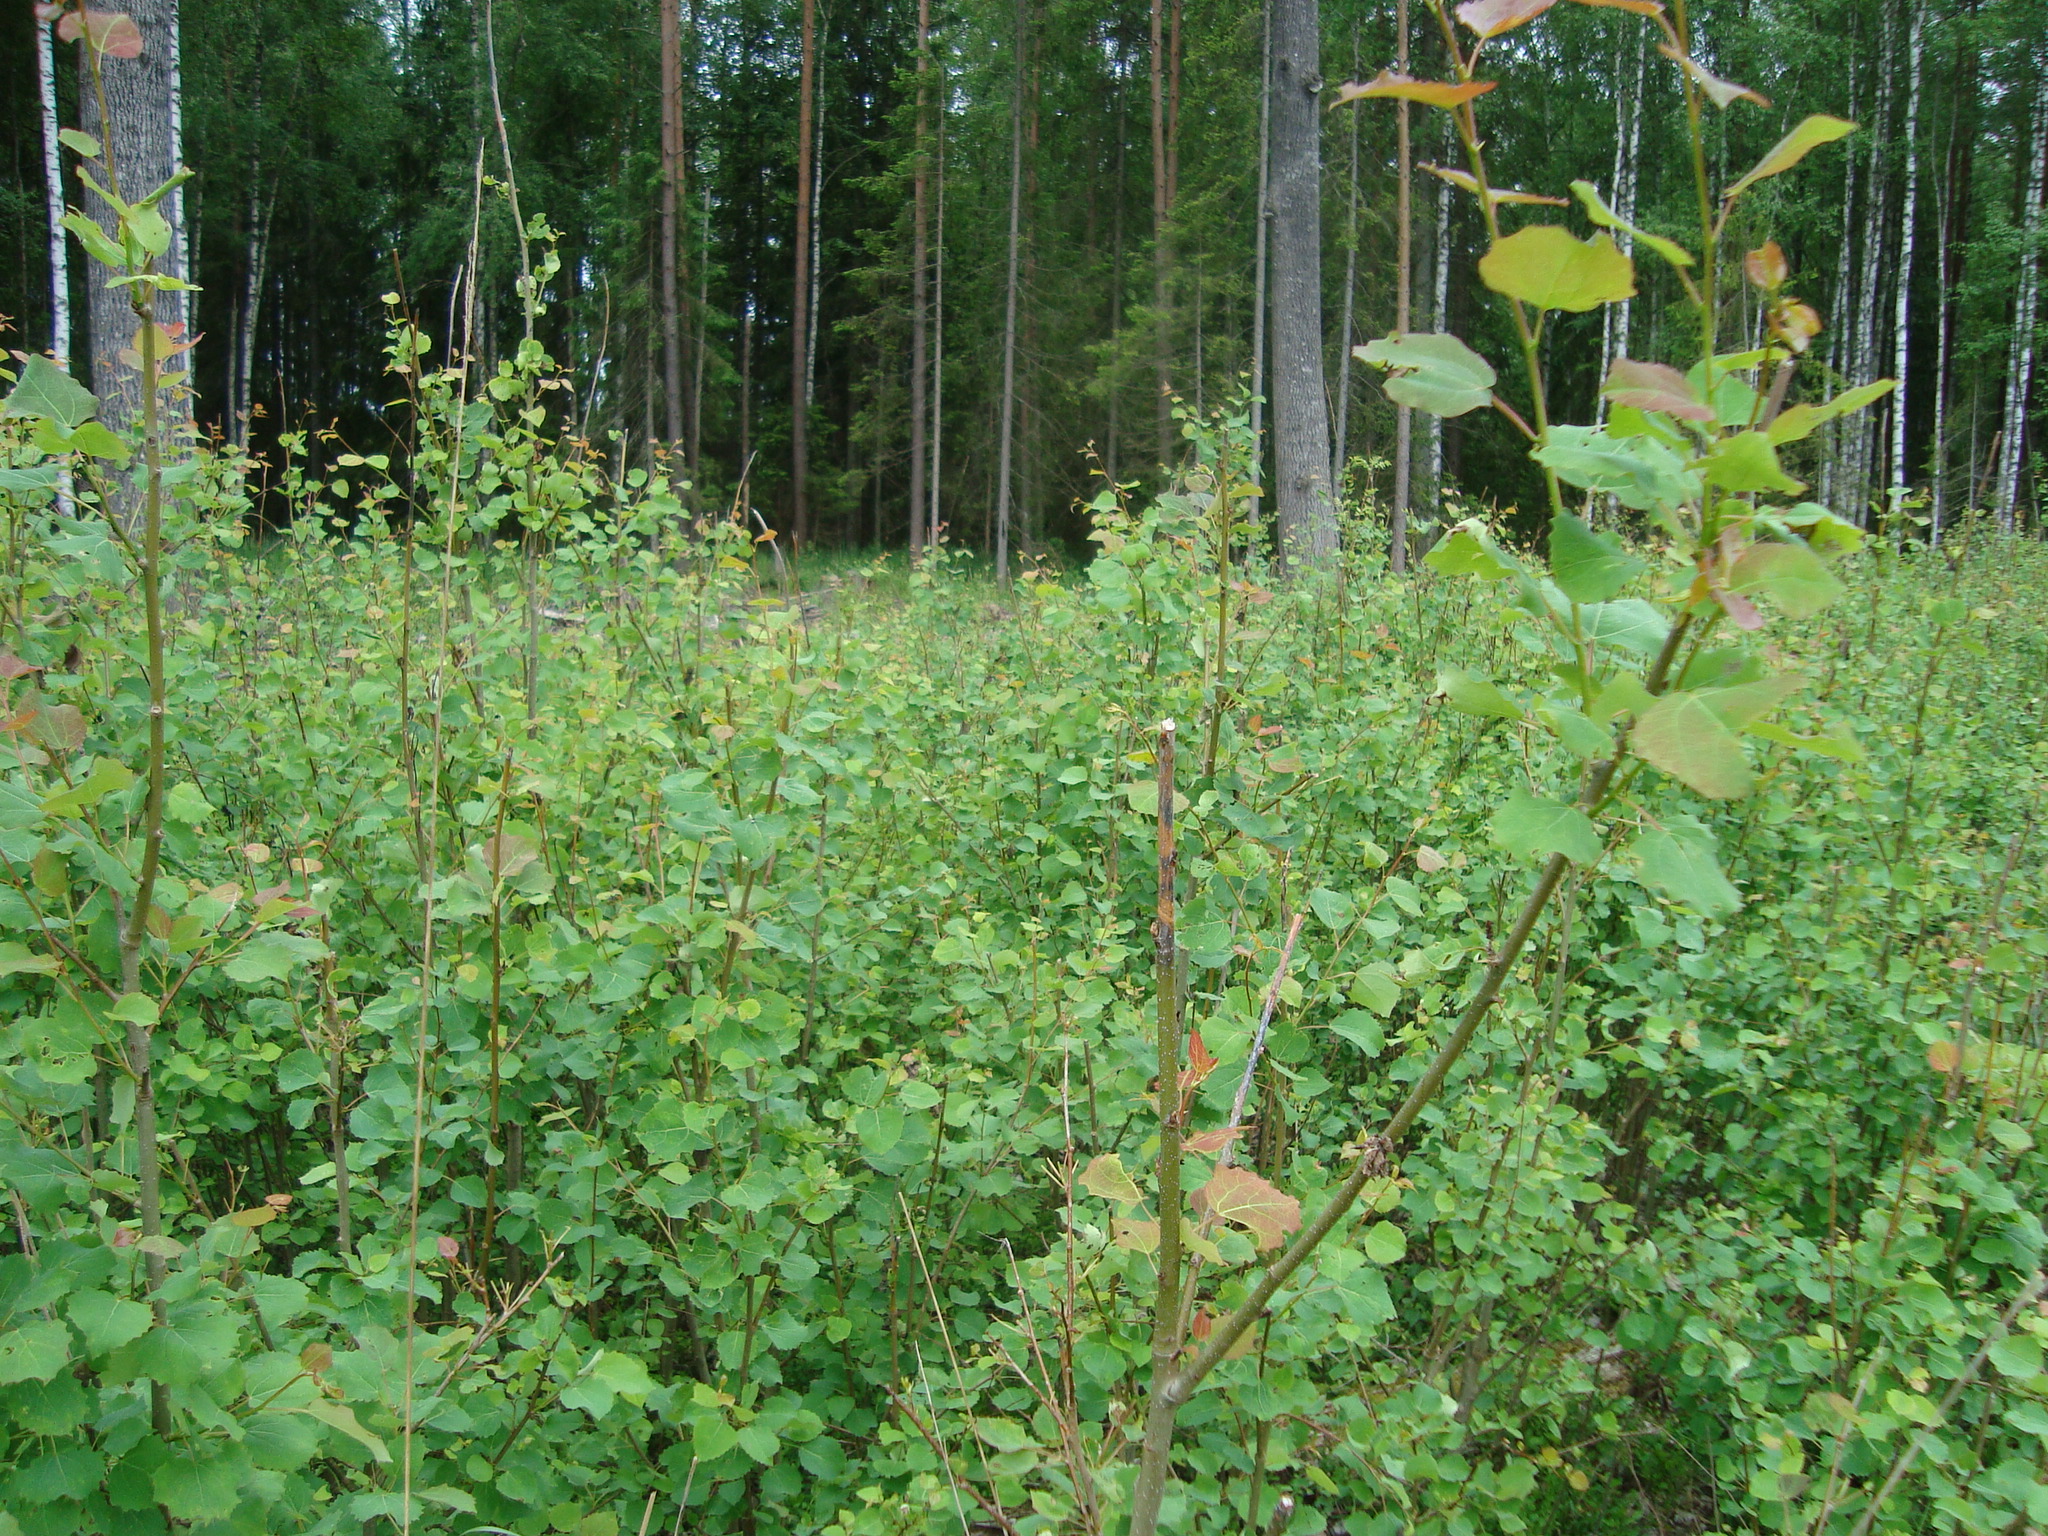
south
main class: Woodland
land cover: Broadleaved woodland
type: non-riverine alder, birch or aspen forest
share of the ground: > 75 %
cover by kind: broadleaved forest trees 80 %, shrubs 15 %, unconsolidated bare surface 5 %
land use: Forestry
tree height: < 5 m
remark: Clear cut
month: June
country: LV
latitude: 56.9965
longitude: 25.6782
